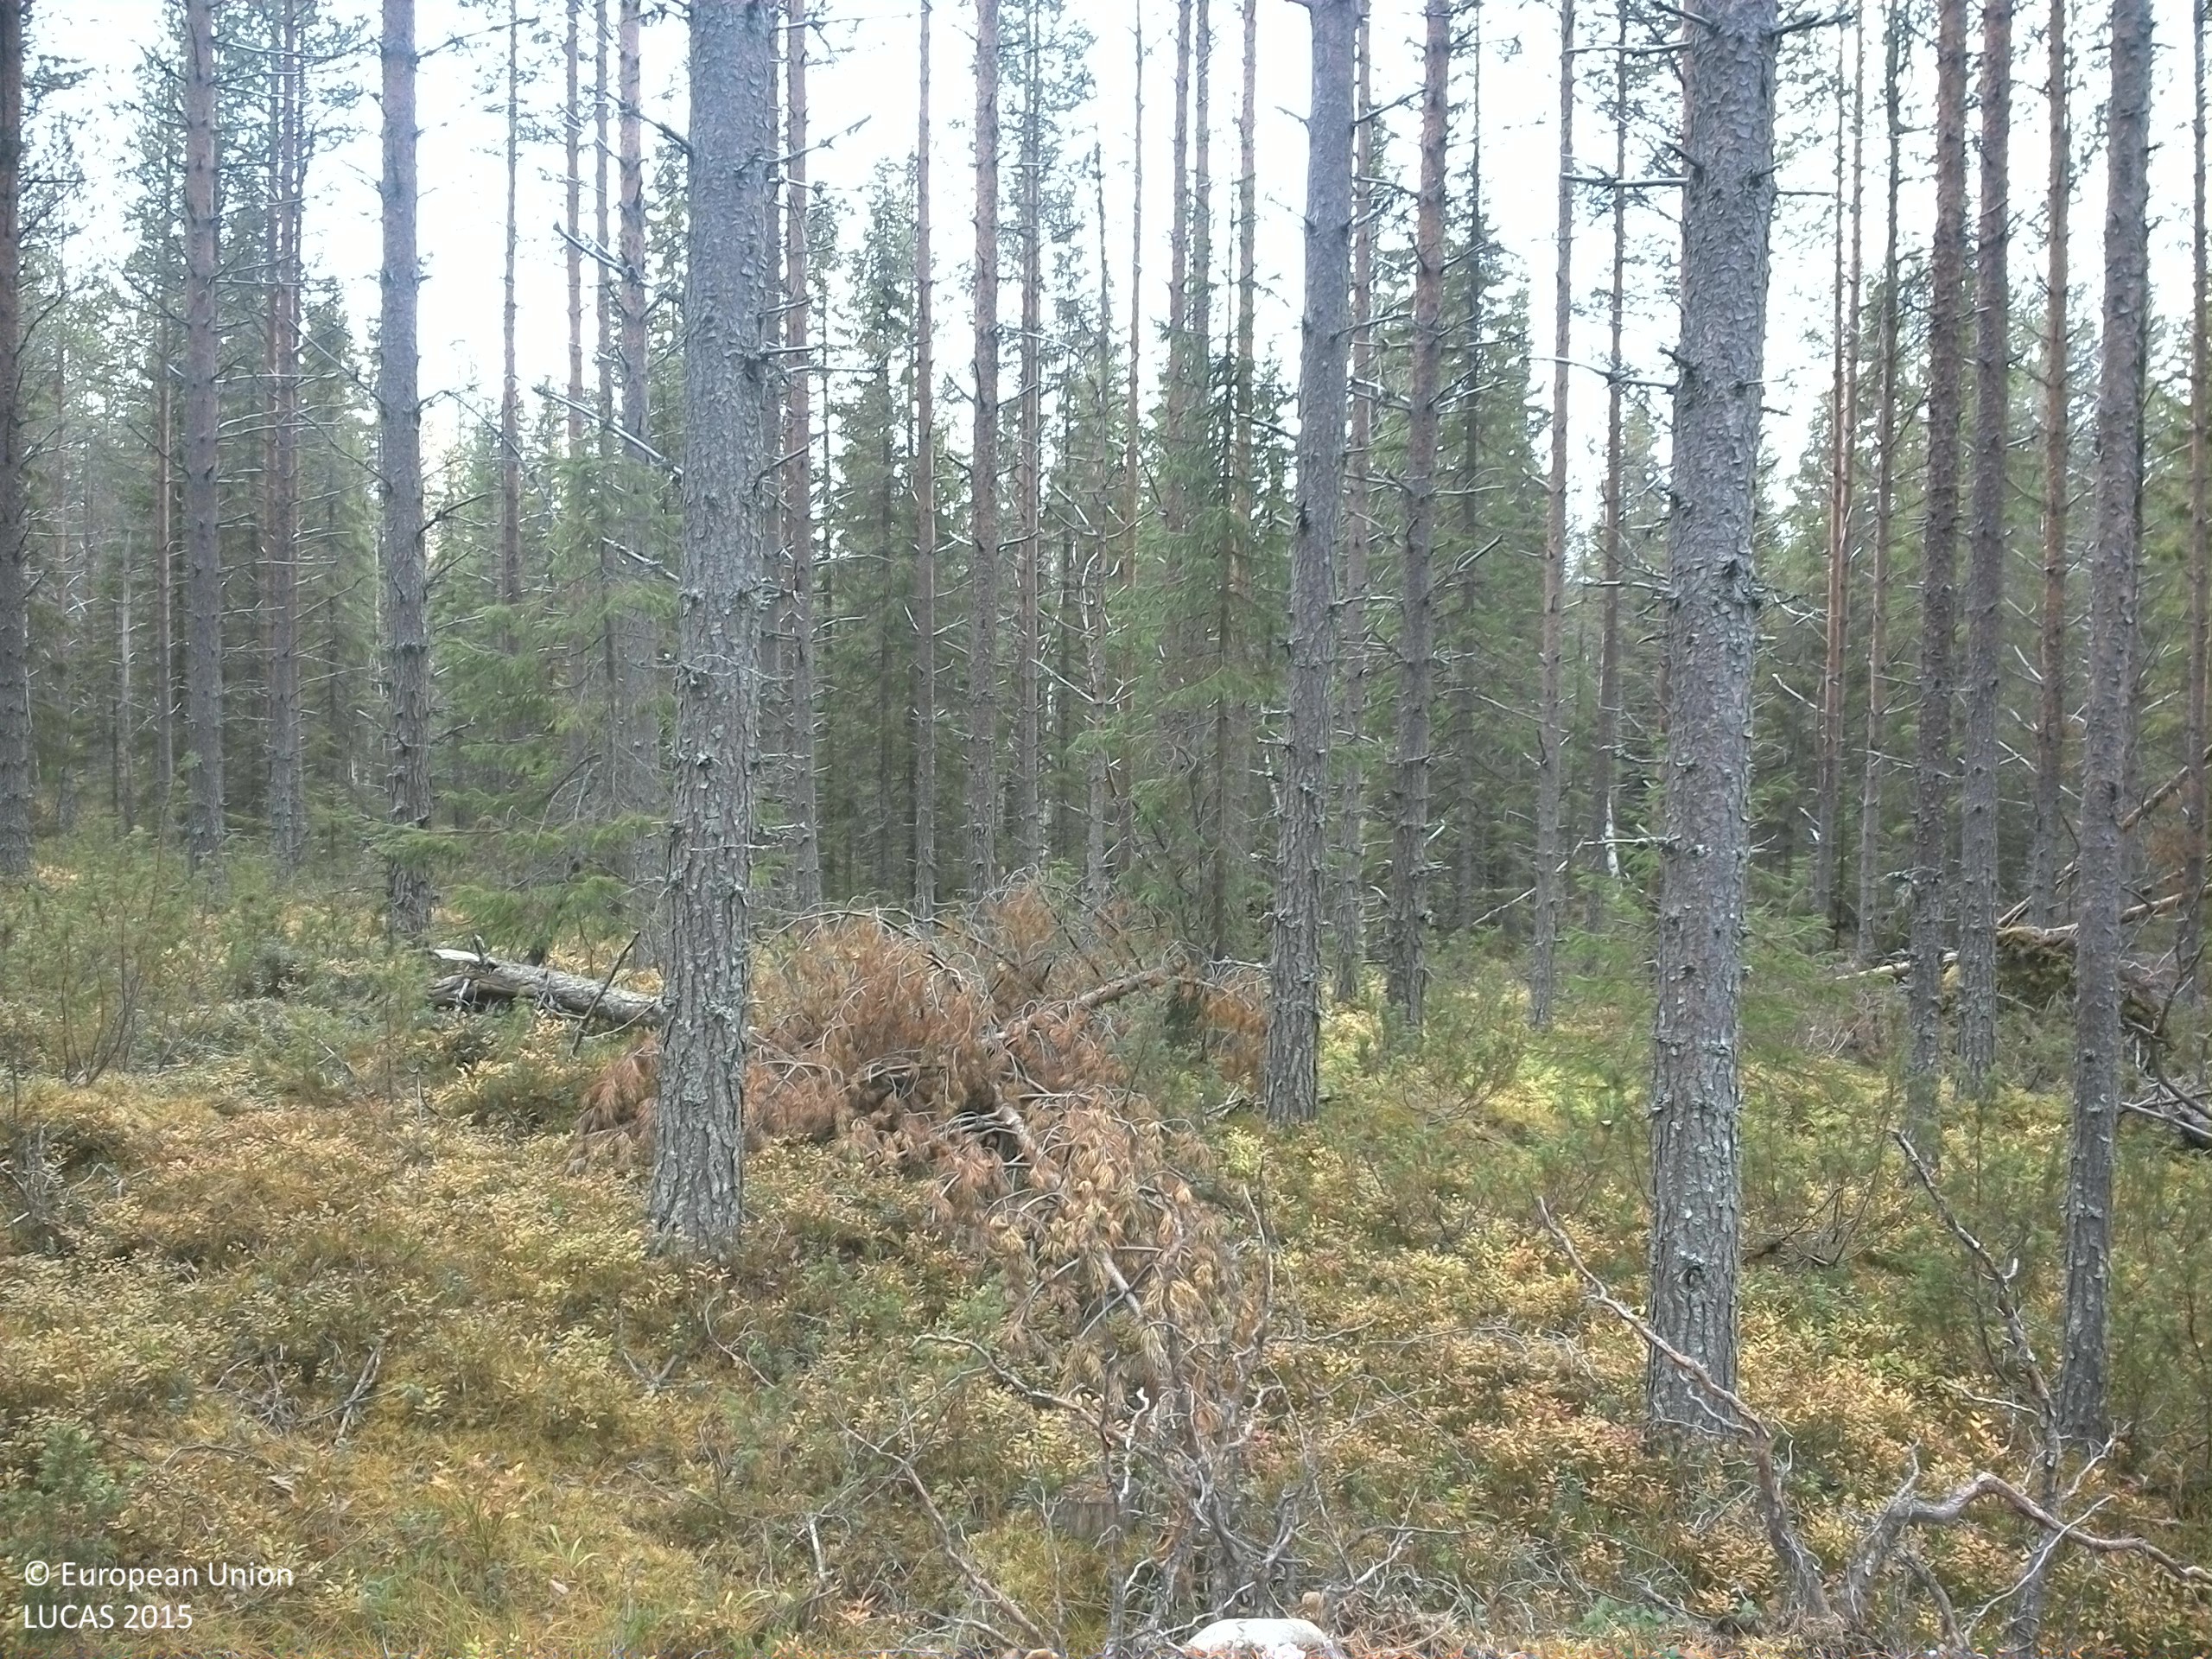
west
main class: Woodland
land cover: Pine dominated coniferous woodland
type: boreal forest
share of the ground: 25 - 50 %
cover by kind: shrubs 45 %, coniferous forest trees 40 %, lichens and mosses 15 %
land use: Forestry
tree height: > 5 m
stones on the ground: < 10 %
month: October
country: SE
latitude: 64.3528
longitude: 15.6236
